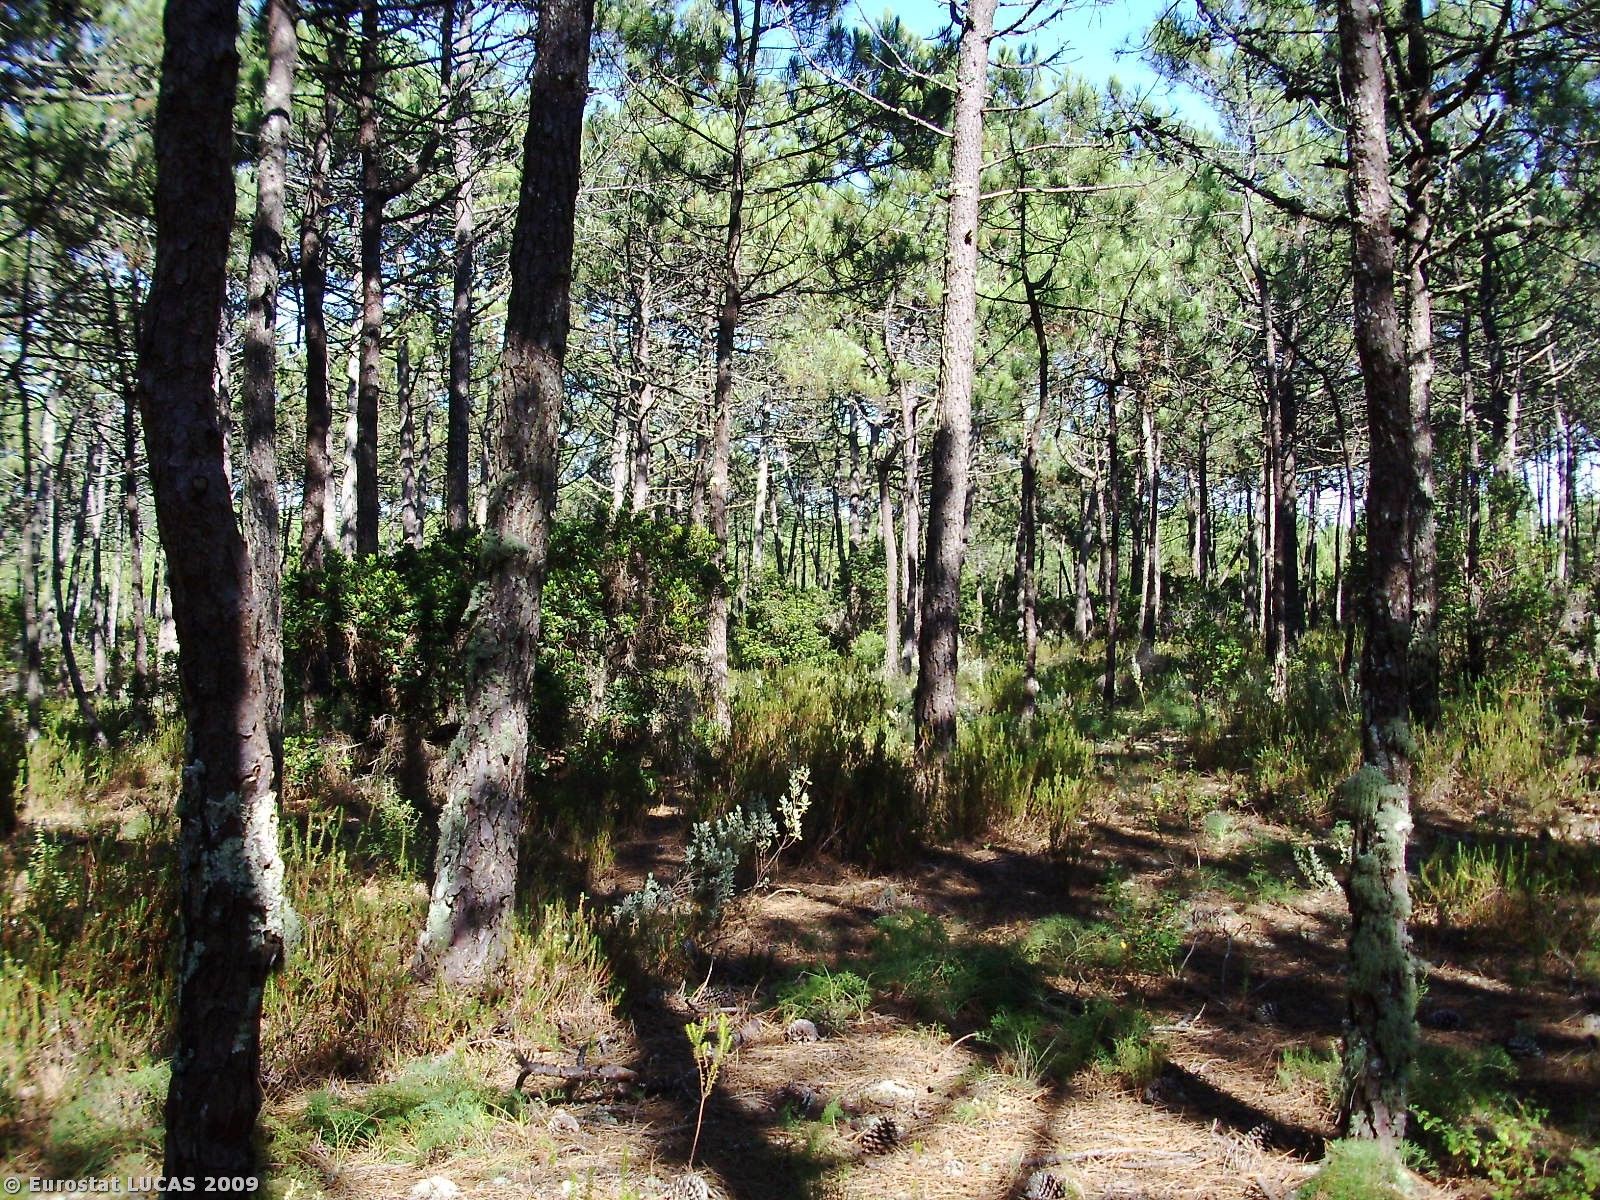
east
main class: Woodland
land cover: Coniferous woodland
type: coniferous forest of the mediterranean region
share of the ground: > 75 %
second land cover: Shrubland with sparse tree cover
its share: 10 - 25 %
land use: Forestry
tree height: > 5 m
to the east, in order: Coniferous woodland; Shrubland with sparse tree cover; Coniferous woodland; Tracks; Shrubland with sparse tree cover; Coniferous woodland
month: August
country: PT
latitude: 39.9042
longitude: -8.9364
